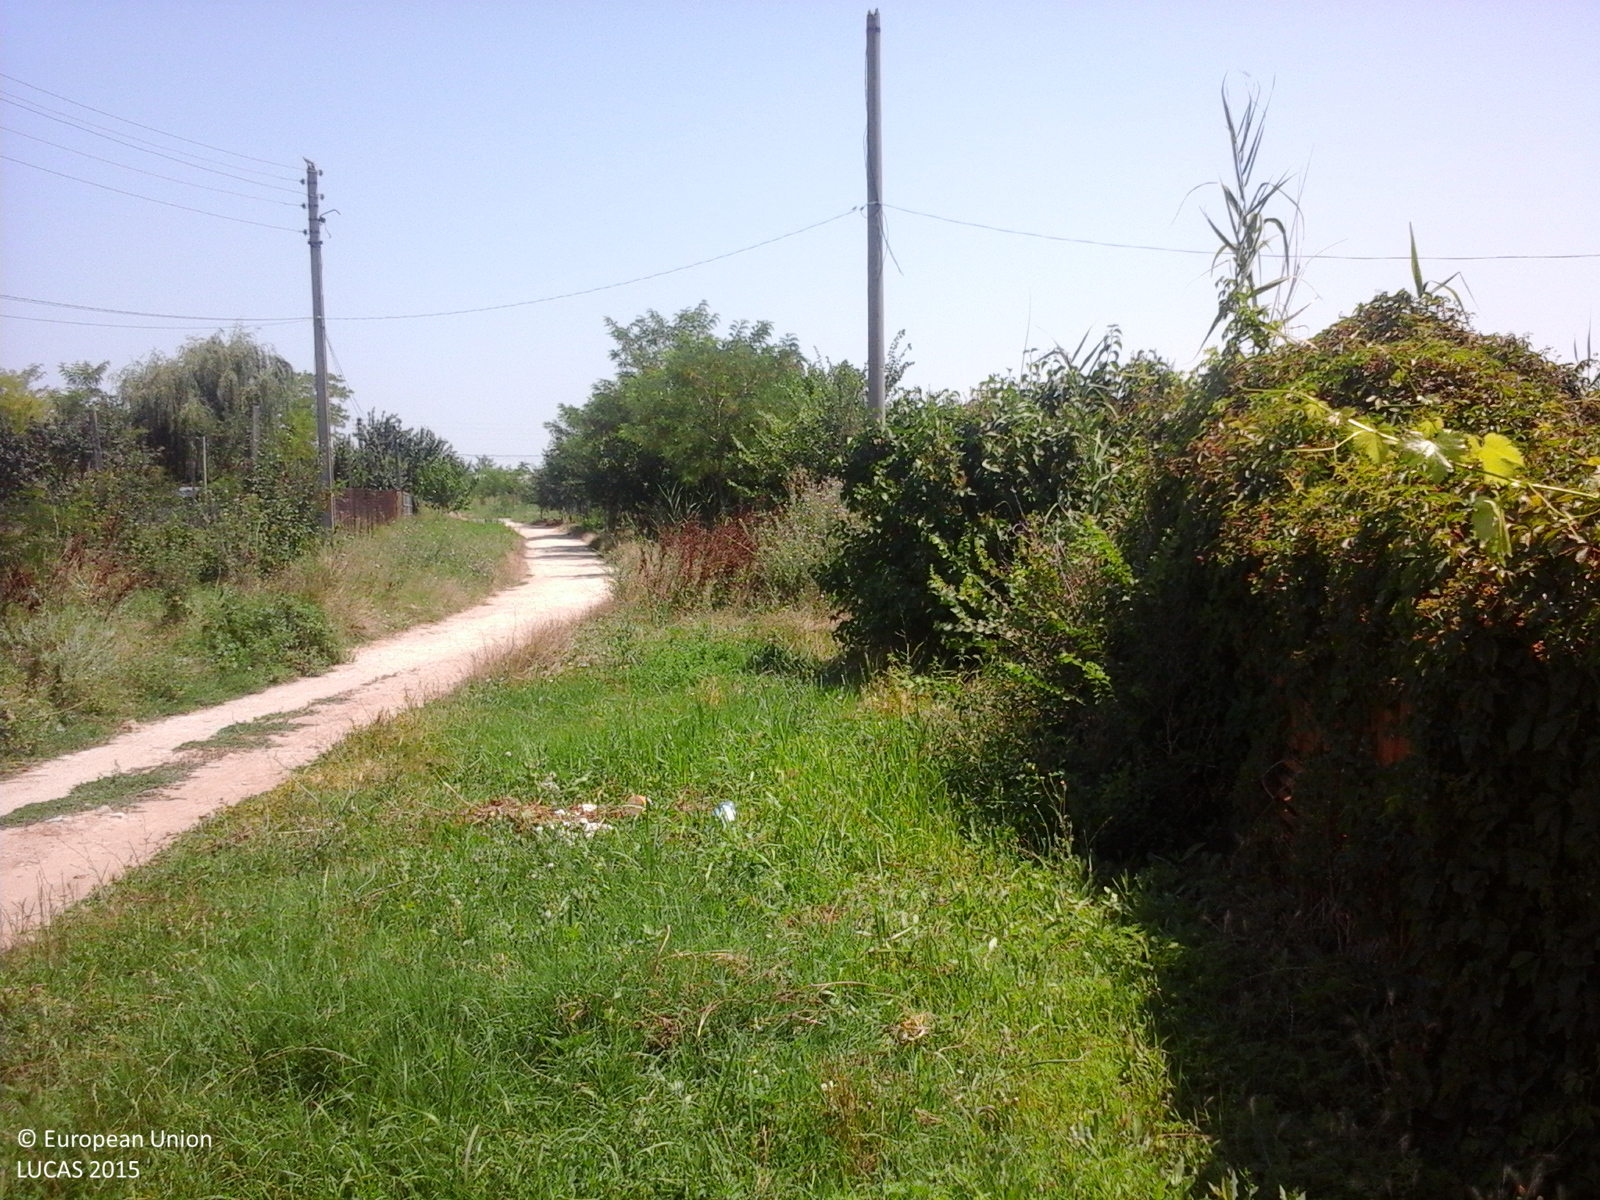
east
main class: Grassland
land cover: Grassland without tree/shrub cover
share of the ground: > 75 %
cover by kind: herbaceous plants 100 %
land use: Residential
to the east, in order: Grassland without tree/shrub cover; Other fresh vegetables; Fences; Inland marshes; Fences; Apple fruit; Artificial constructions in urban areas; Spontaneously vegetated surfaces; Artificial constructions in urban areas; Abandoned hedges; Spontaneously vegetated surfaces; Artificial constructions in urban areas
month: July
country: RO
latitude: 44.5856
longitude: 27.2540
